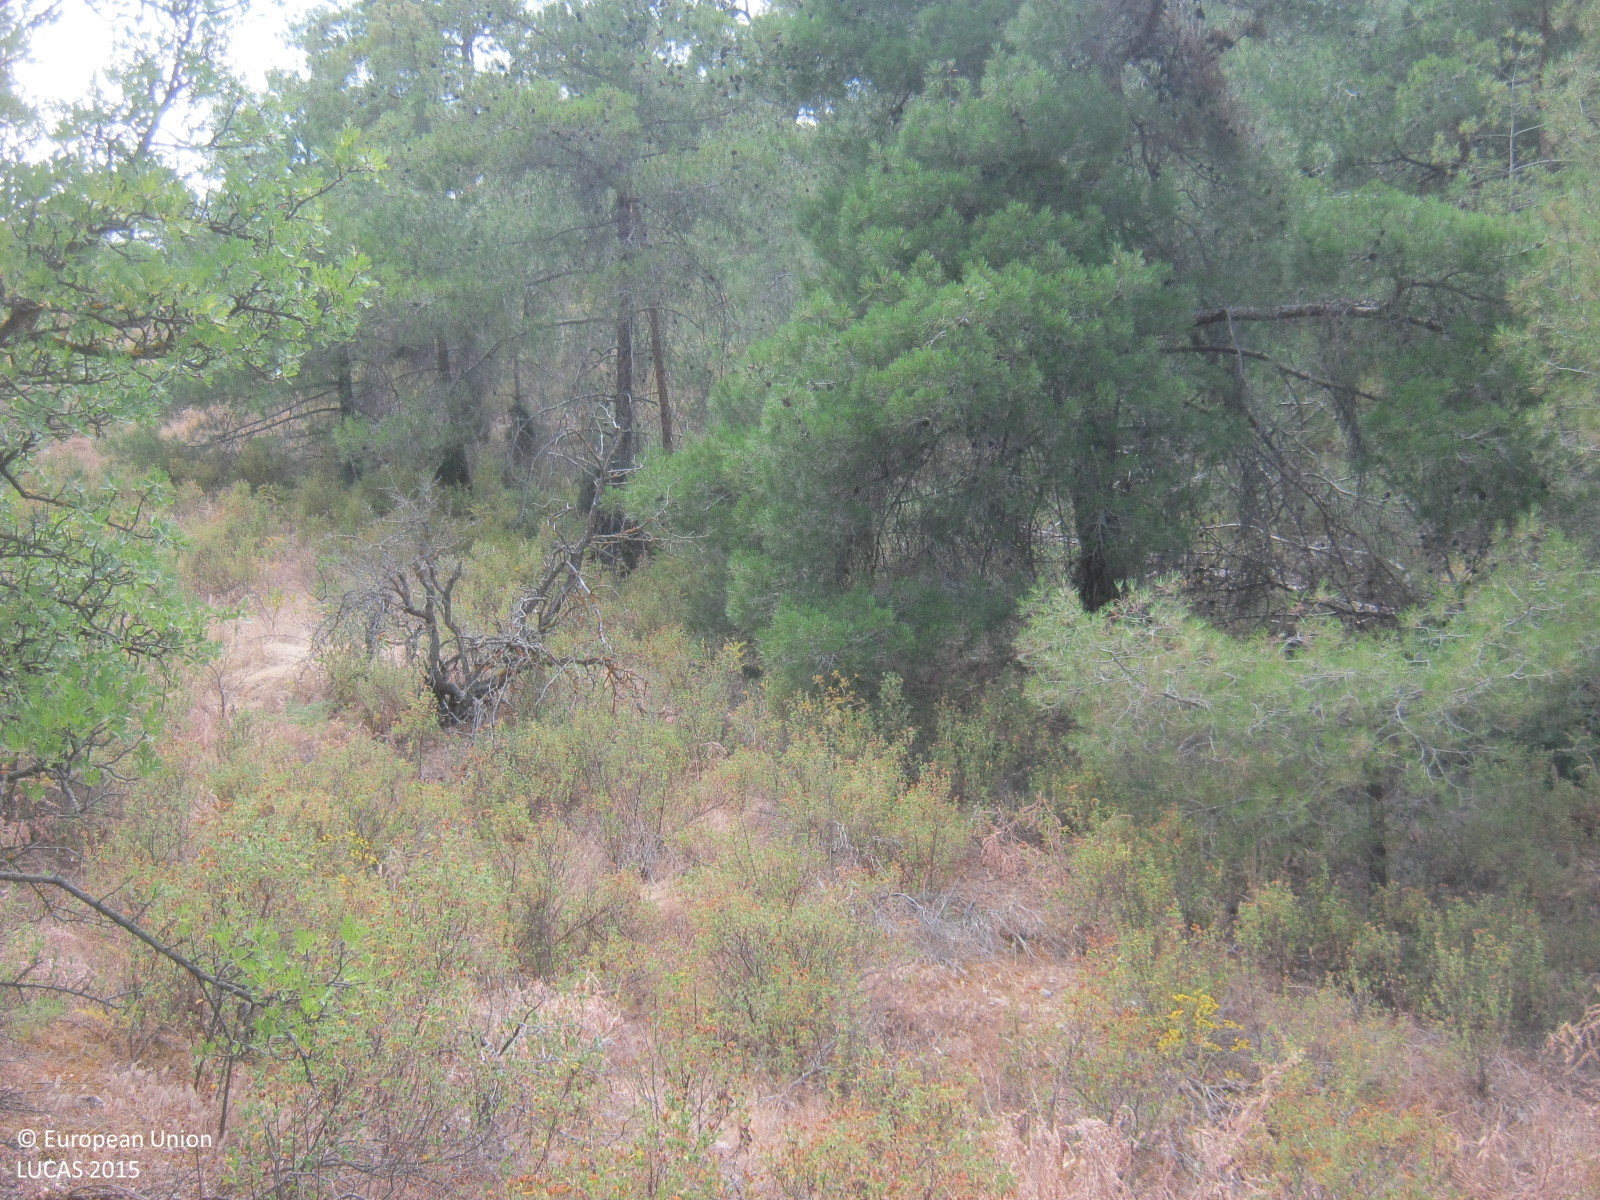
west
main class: Woodland
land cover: Pine dominated coniferous woodland
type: coniferous forest of the mediterranean region
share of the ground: 50 - 75 %
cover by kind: coniferous forest trees 60 %, shrubs 20 %, herbaceous plants 10 %, unconsolidated bare surface 10 %
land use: Forestry
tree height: > 5 m
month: June
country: CY
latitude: 34.9752
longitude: 33.1711
